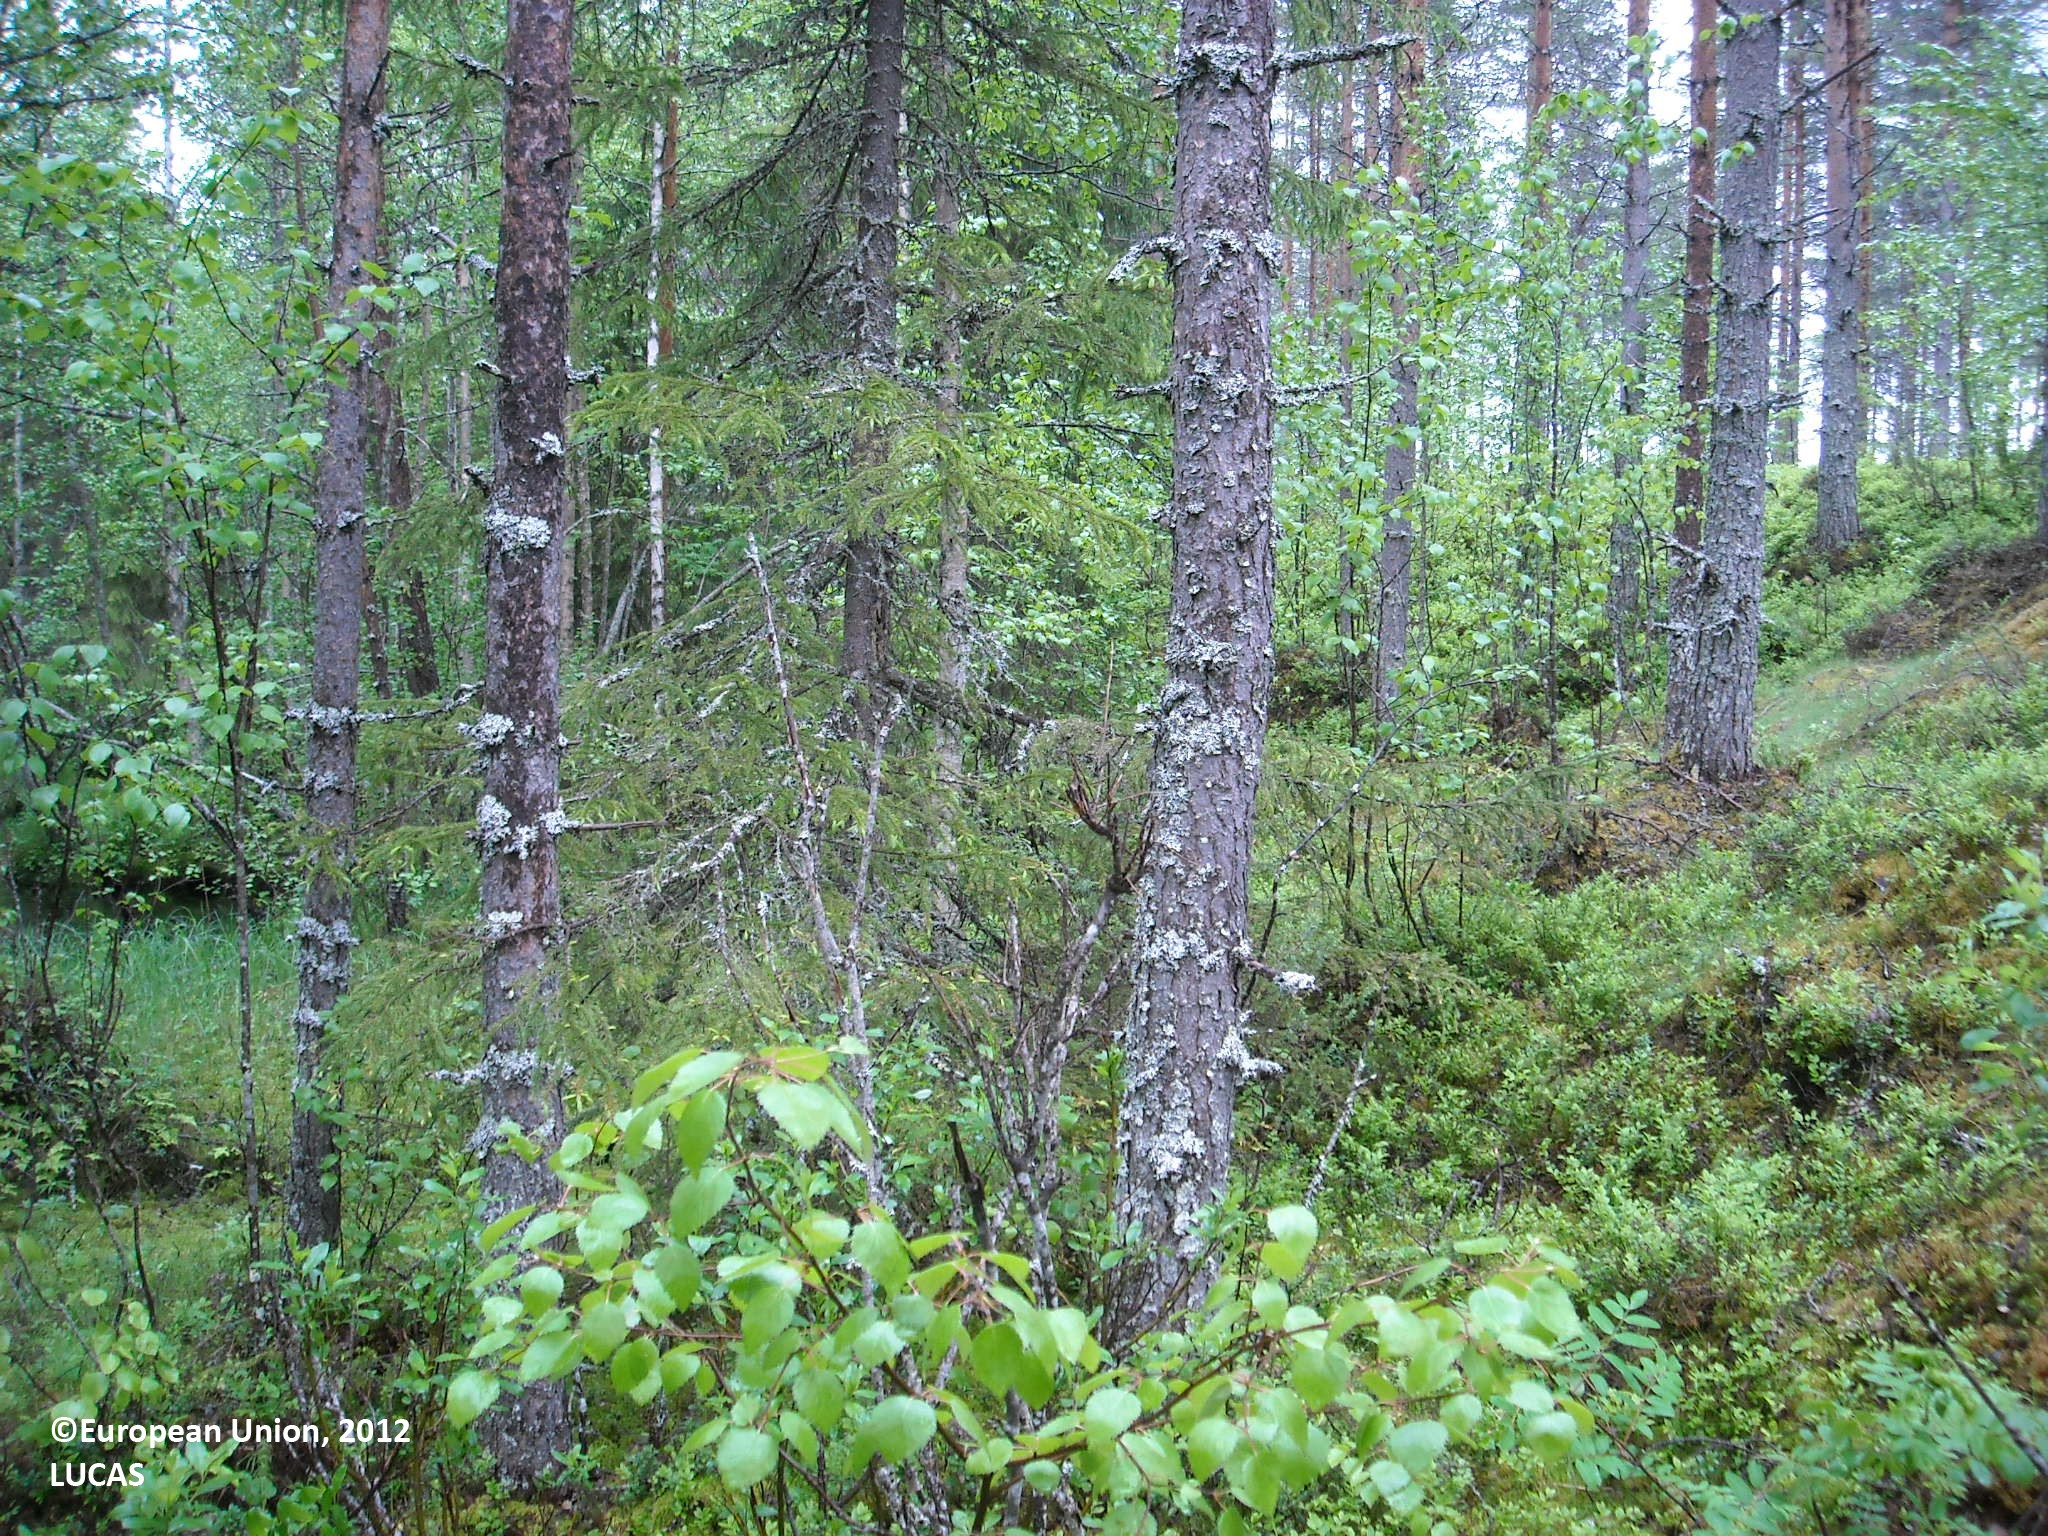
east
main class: Woodland
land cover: Pine dominated mixed woodland
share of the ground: > 75 %
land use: Forestry
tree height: > 5 m
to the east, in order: Pine dominated mixed woodland; Other mixed woodland; Pine dominated mixed woodland; Broadleaved woodland; Ditches and canals; Pine dominated mixed woodland; Other mixed woodland
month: June
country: FI
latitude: 65.4948
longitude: 27.8804
